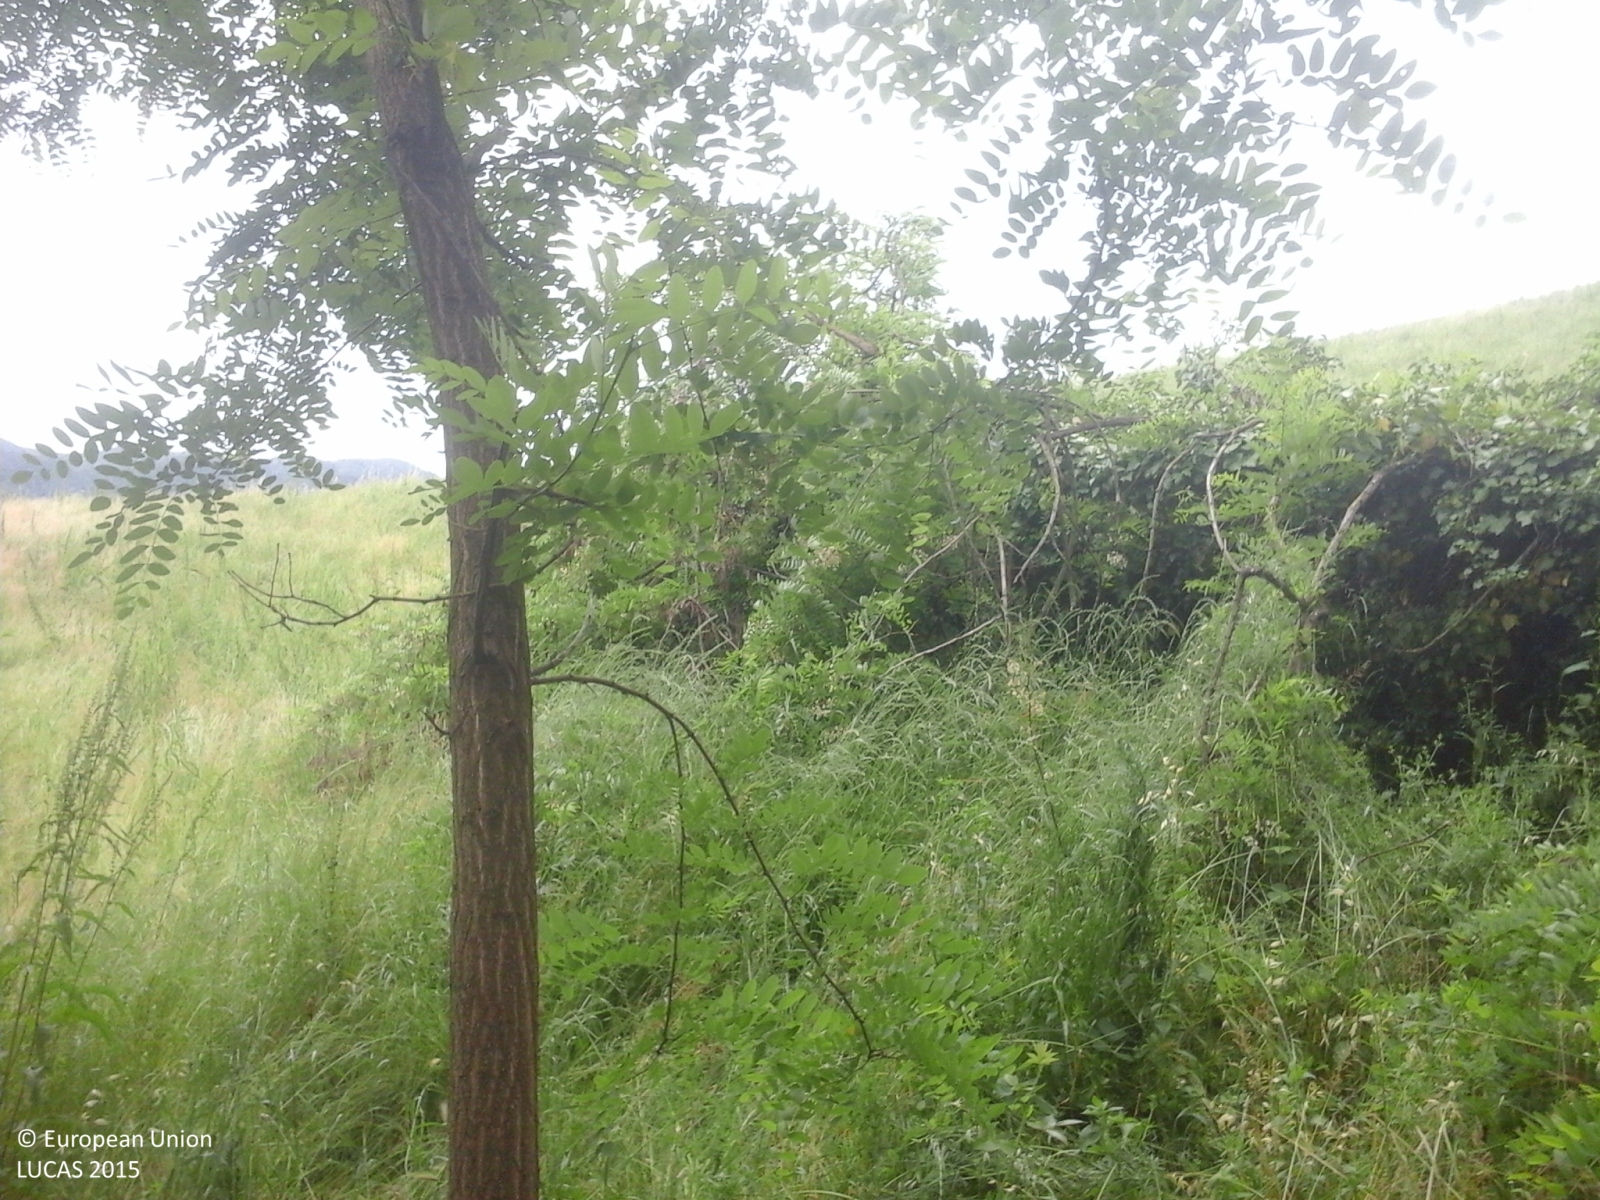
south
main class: Woodland
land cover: Broadleaved woodland
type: thermophilous deciduous forest
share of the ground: > 75 %
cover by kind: broadleaved forest trees 100 %
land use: Forestry
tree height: > 5 m
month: May
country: IT
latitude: 44.4162
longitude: 11.1654
